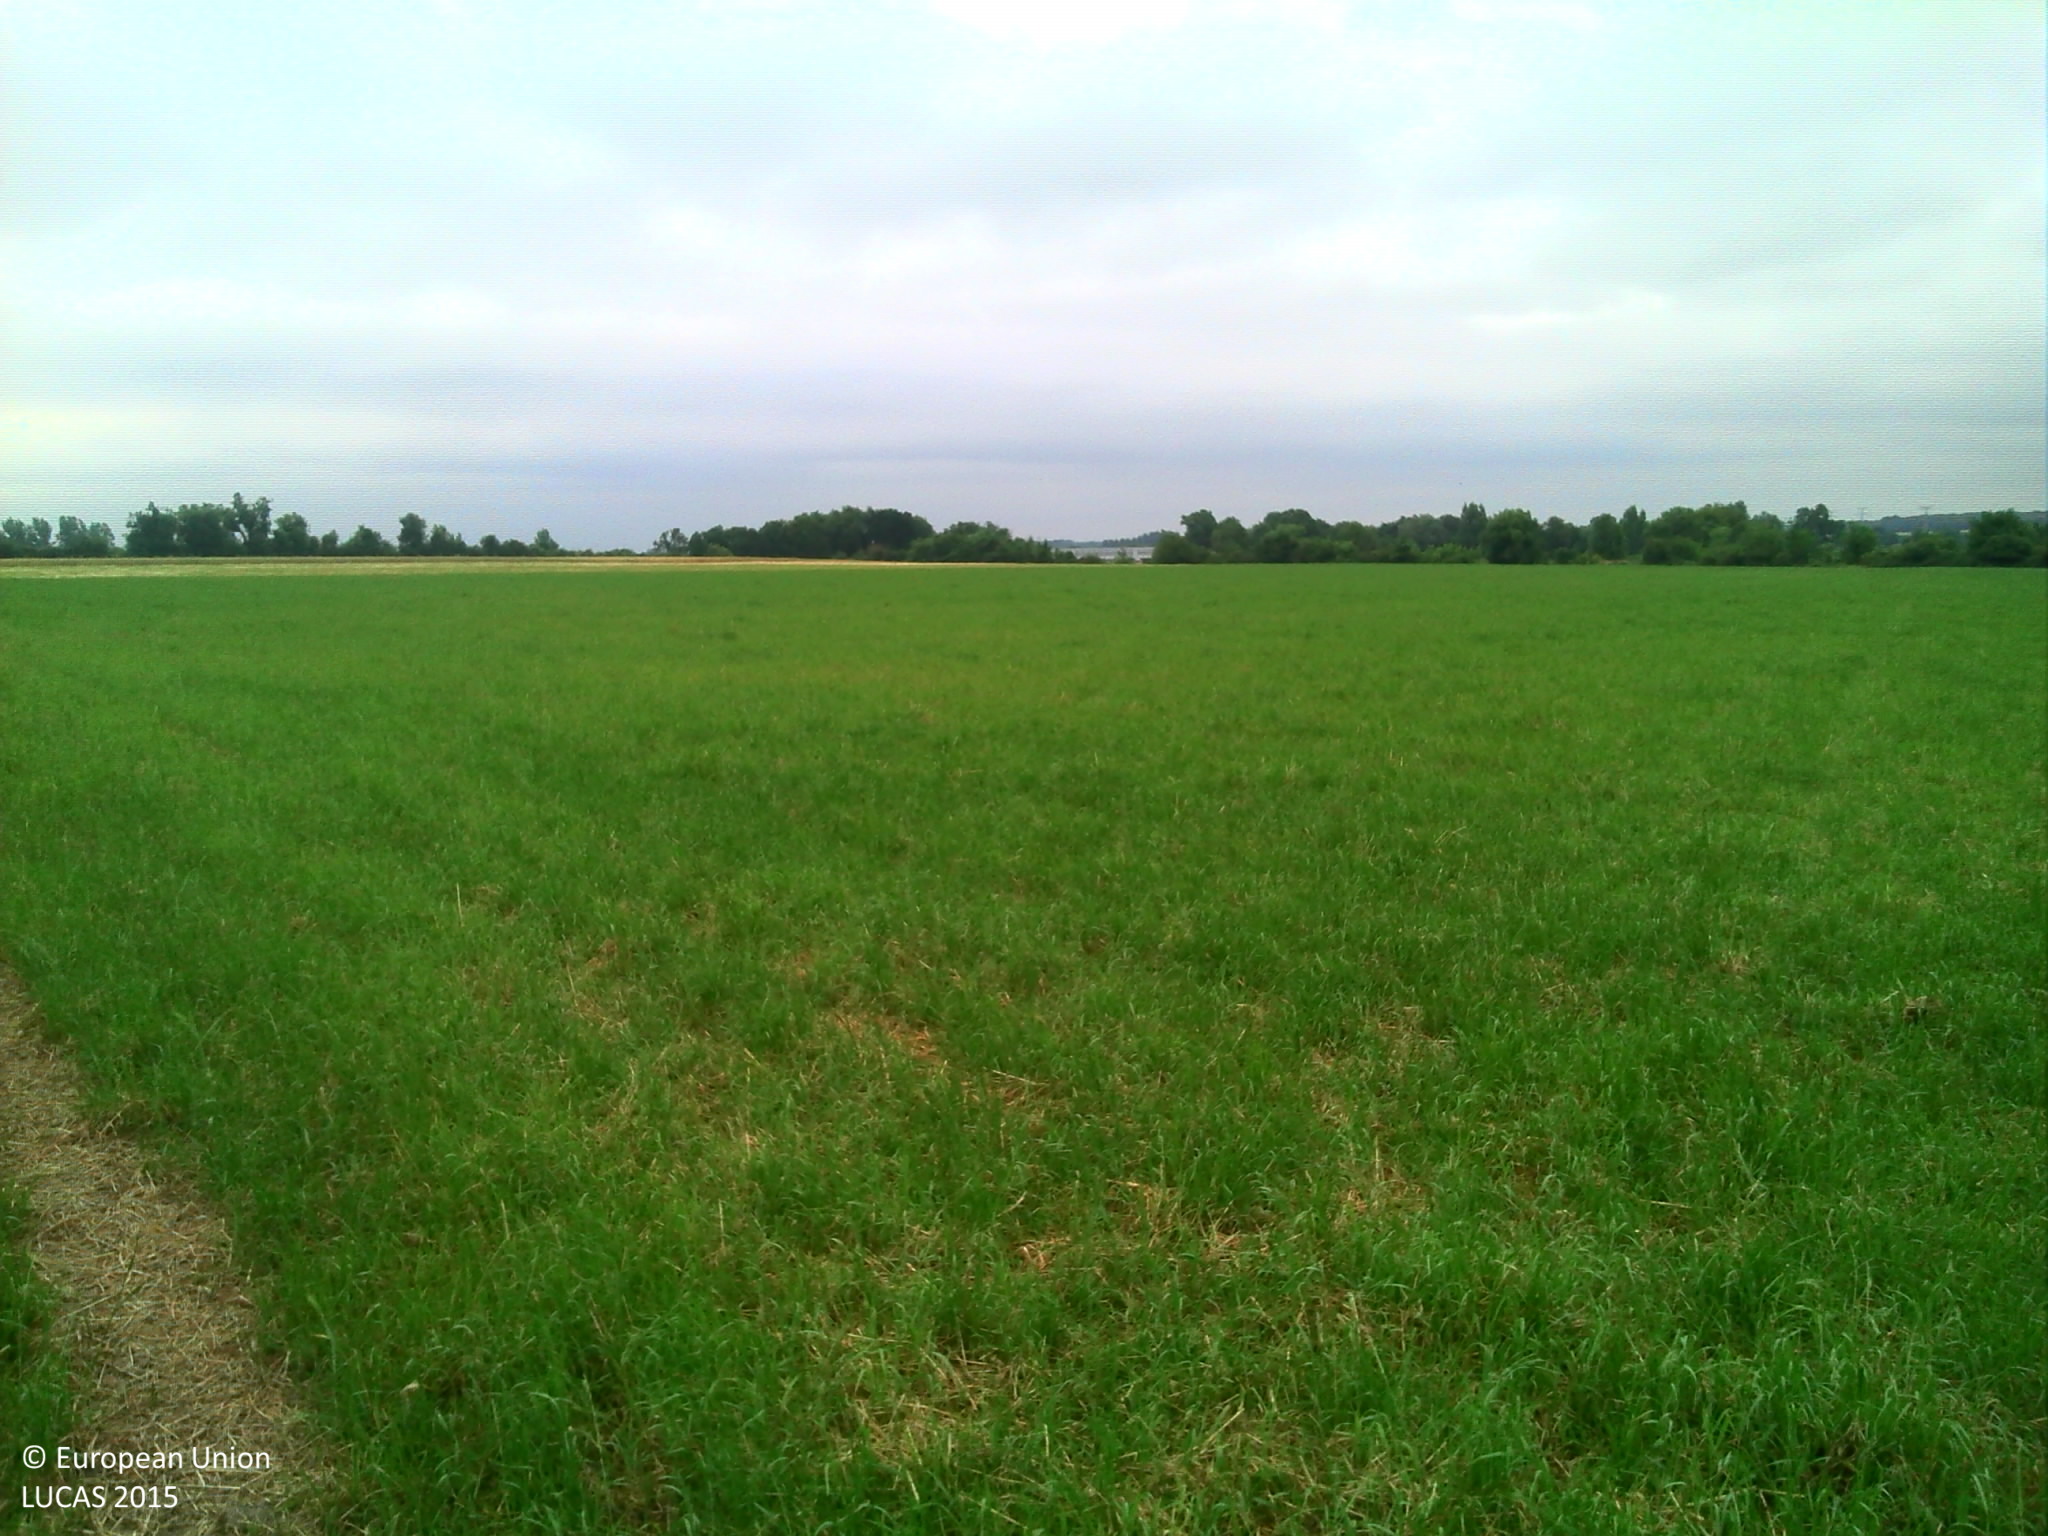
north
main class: Grassland
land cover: Grassland without tree/shrub cover
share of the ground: > 75 %
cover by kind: herbaceous plants 100 %
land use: Agriculture (excluding fallow land and kitchen gardens)
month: June
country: FR
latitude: 45.9047
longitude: -0.8682
